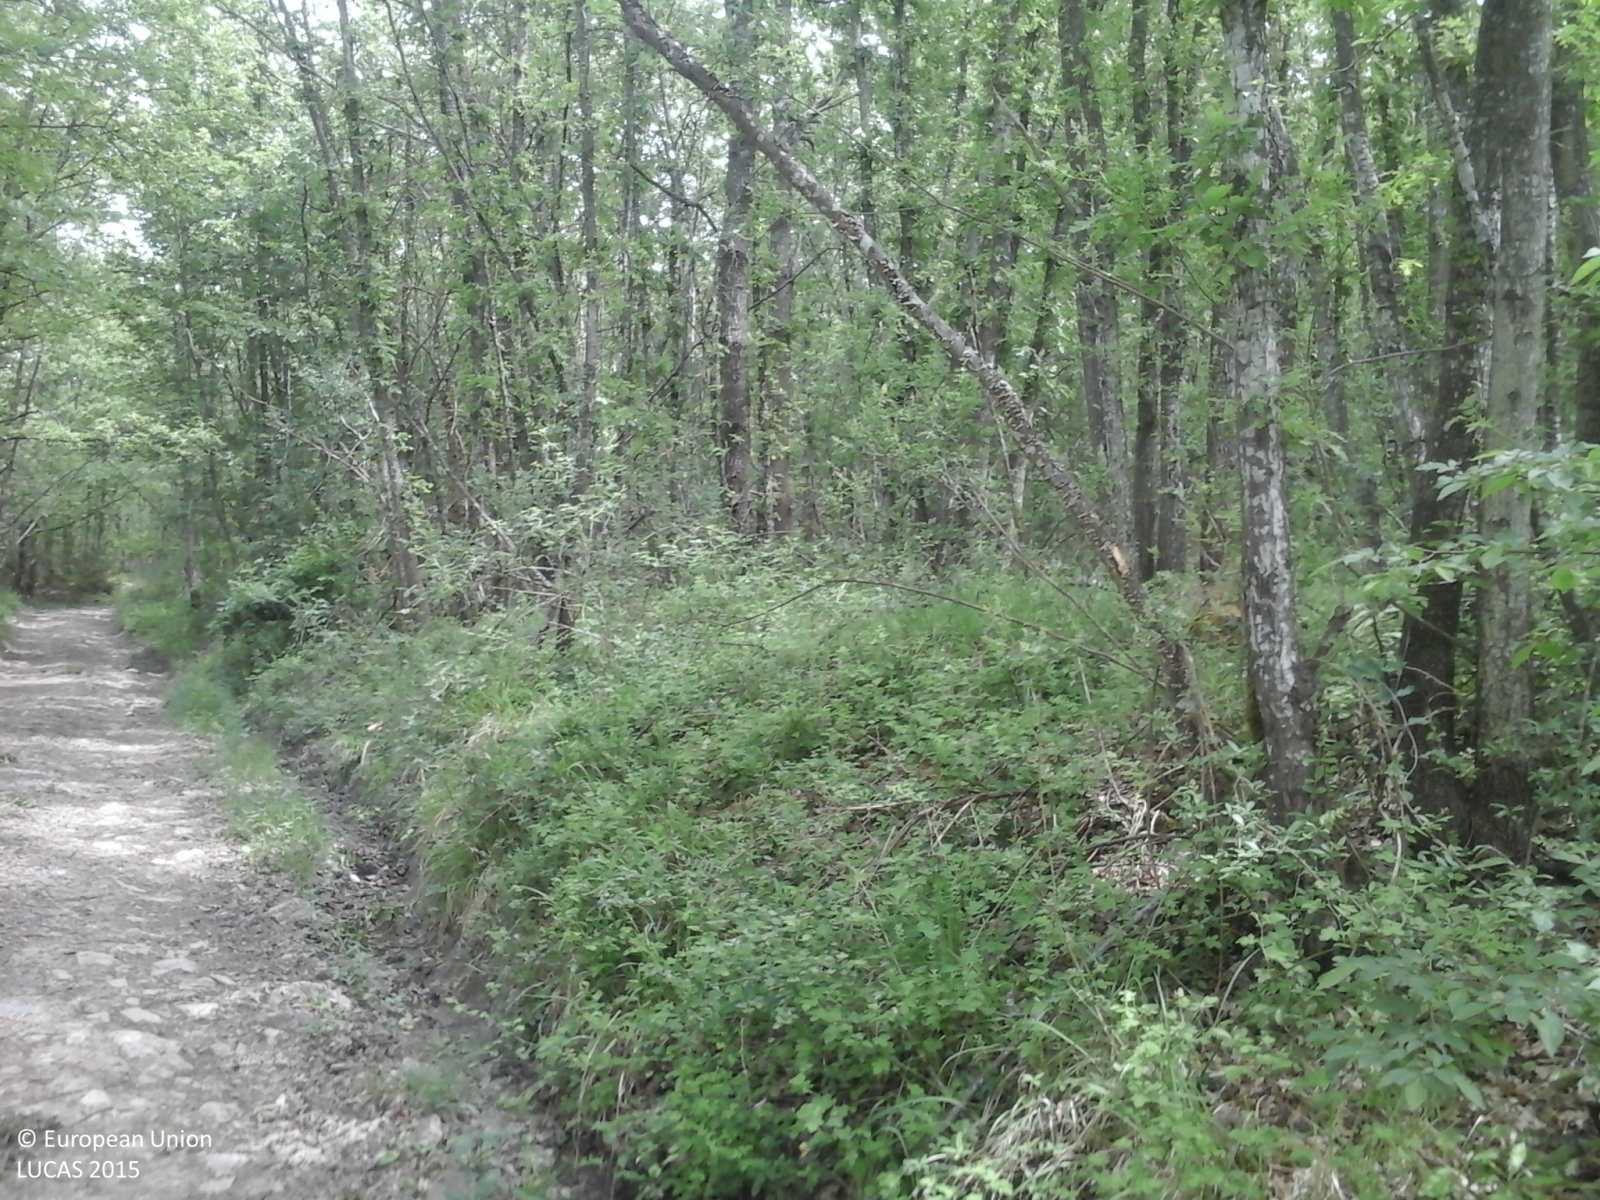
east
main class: Woodland
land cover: Broadleaved woodland
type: thermophilous deciduous forest
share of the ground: > 75 %
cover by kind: broadleaved forest trees 90 %, shrubs 5 %, herbaceous plants 5 %
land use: Forestry
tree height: > 5 m
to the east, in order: Broadleaved woodland
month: May
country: IT
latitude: 44.2388
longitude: 10.8619
